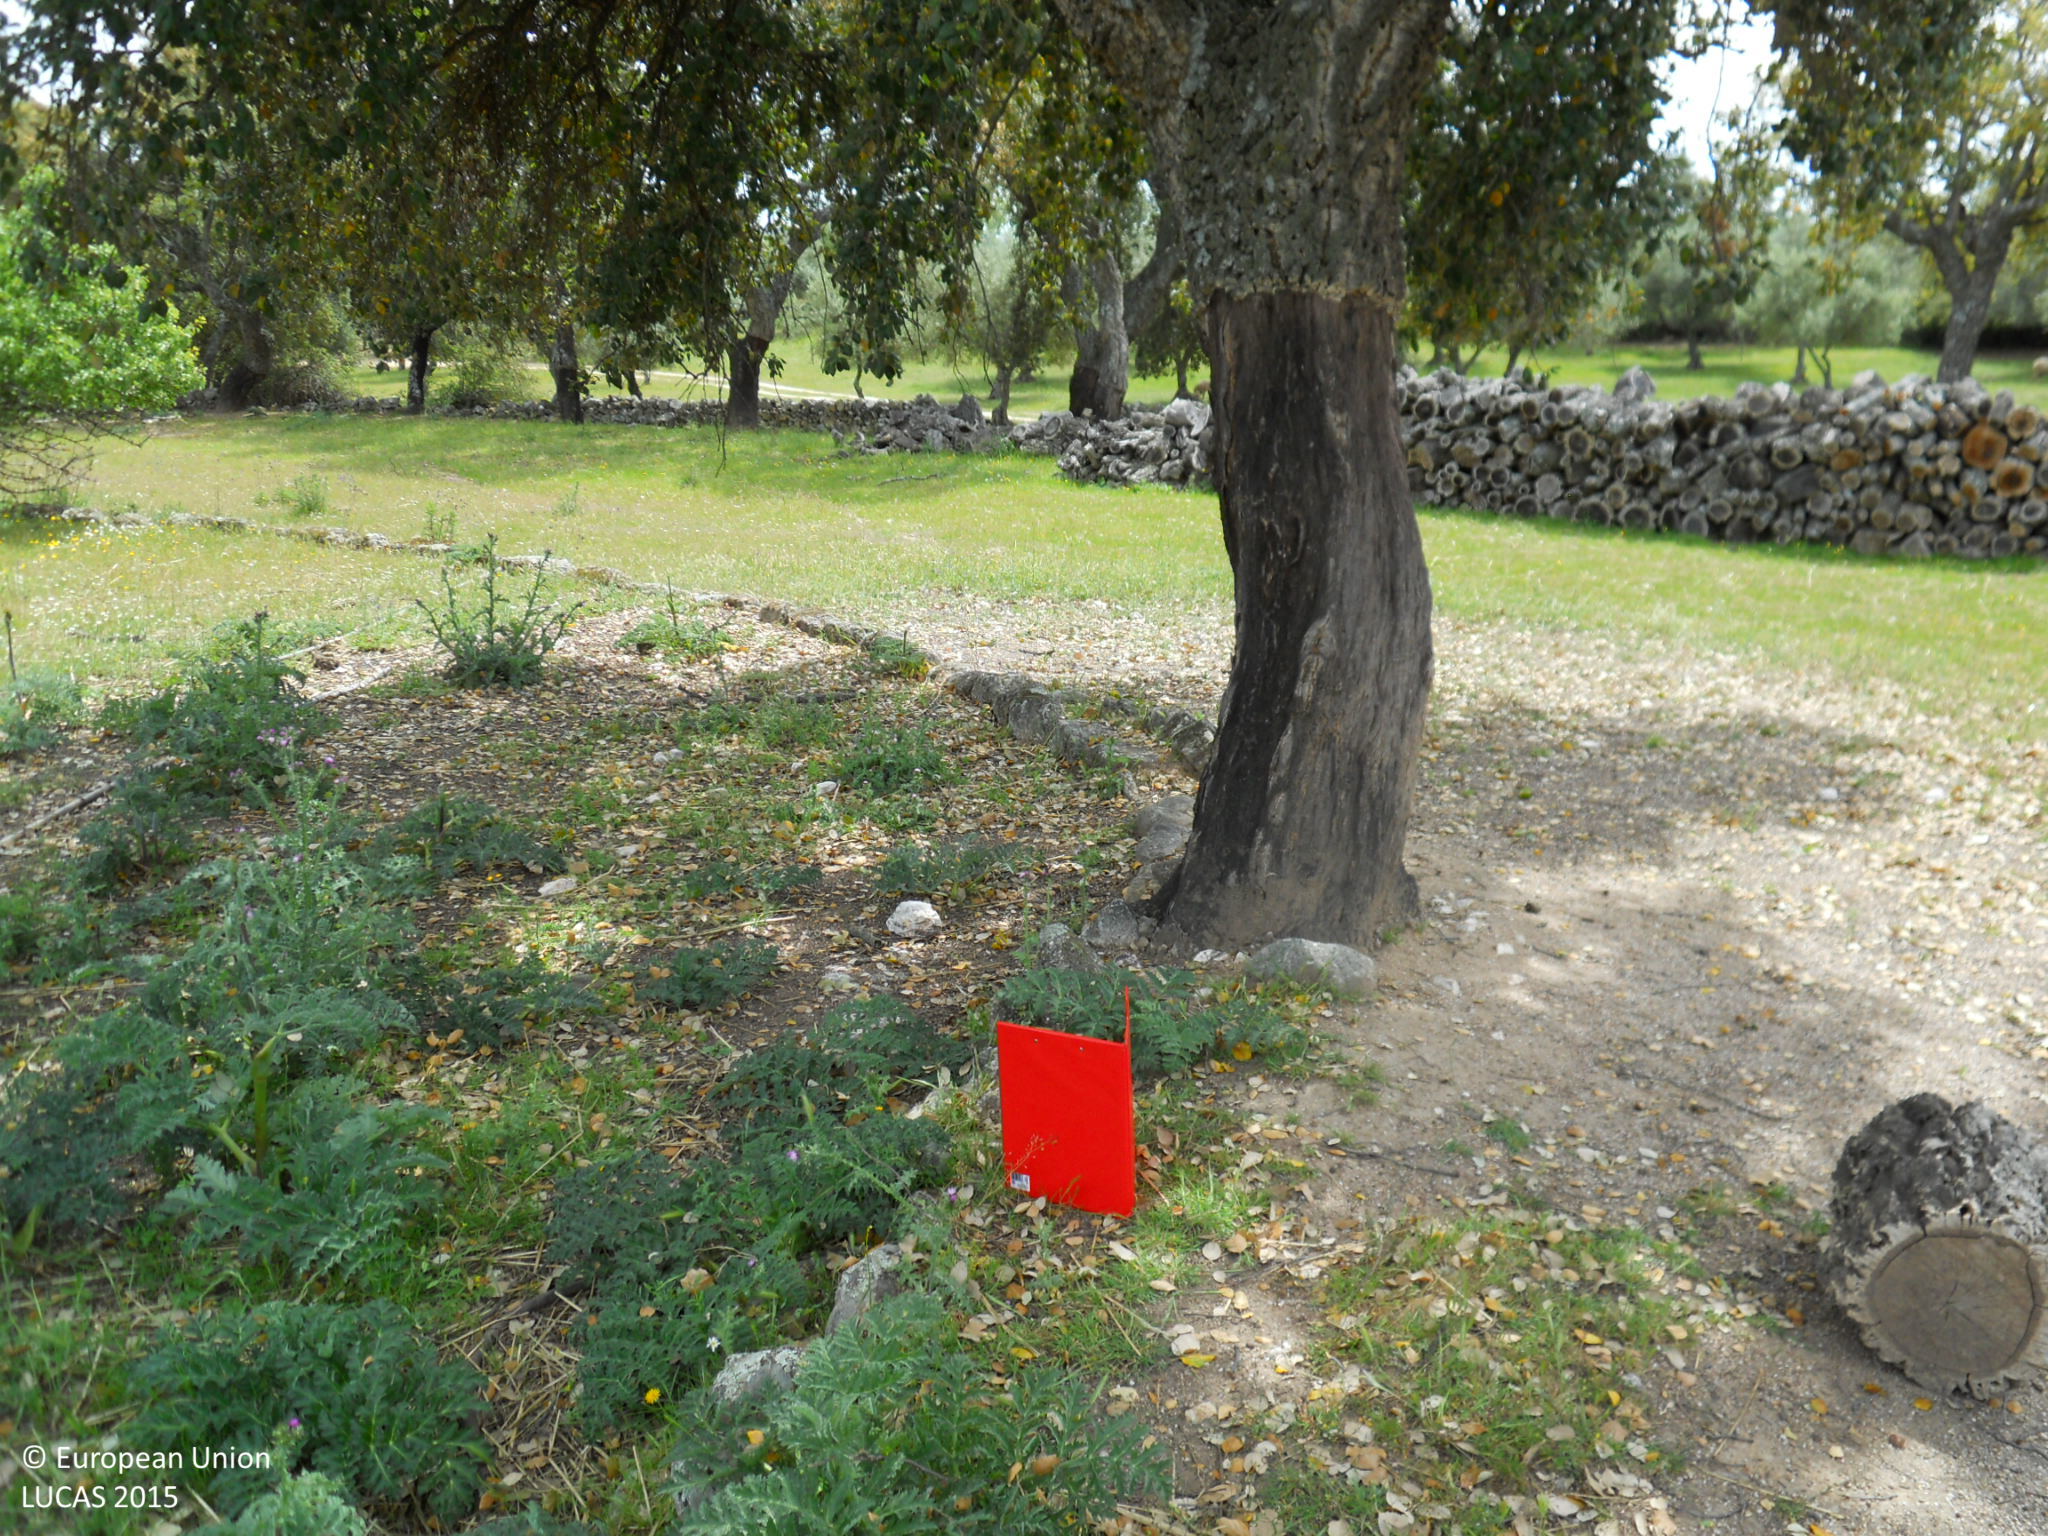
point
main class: Woodland
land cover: Broadleaved woodland
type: broadleaved evergreen forest
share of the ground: 25 - 50 %
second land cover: Grassland without tree/shrub cover
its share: > 75 %
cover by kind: herbaceous plants 80 %, broadleaved forest trees 15 %, shrubs 5 %
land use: Forestry
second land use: Agriculture (excluding fallow land and kitchen gardens)
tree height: > 5 m
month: April
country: ES
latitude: 39.3216
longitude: -7.1207
